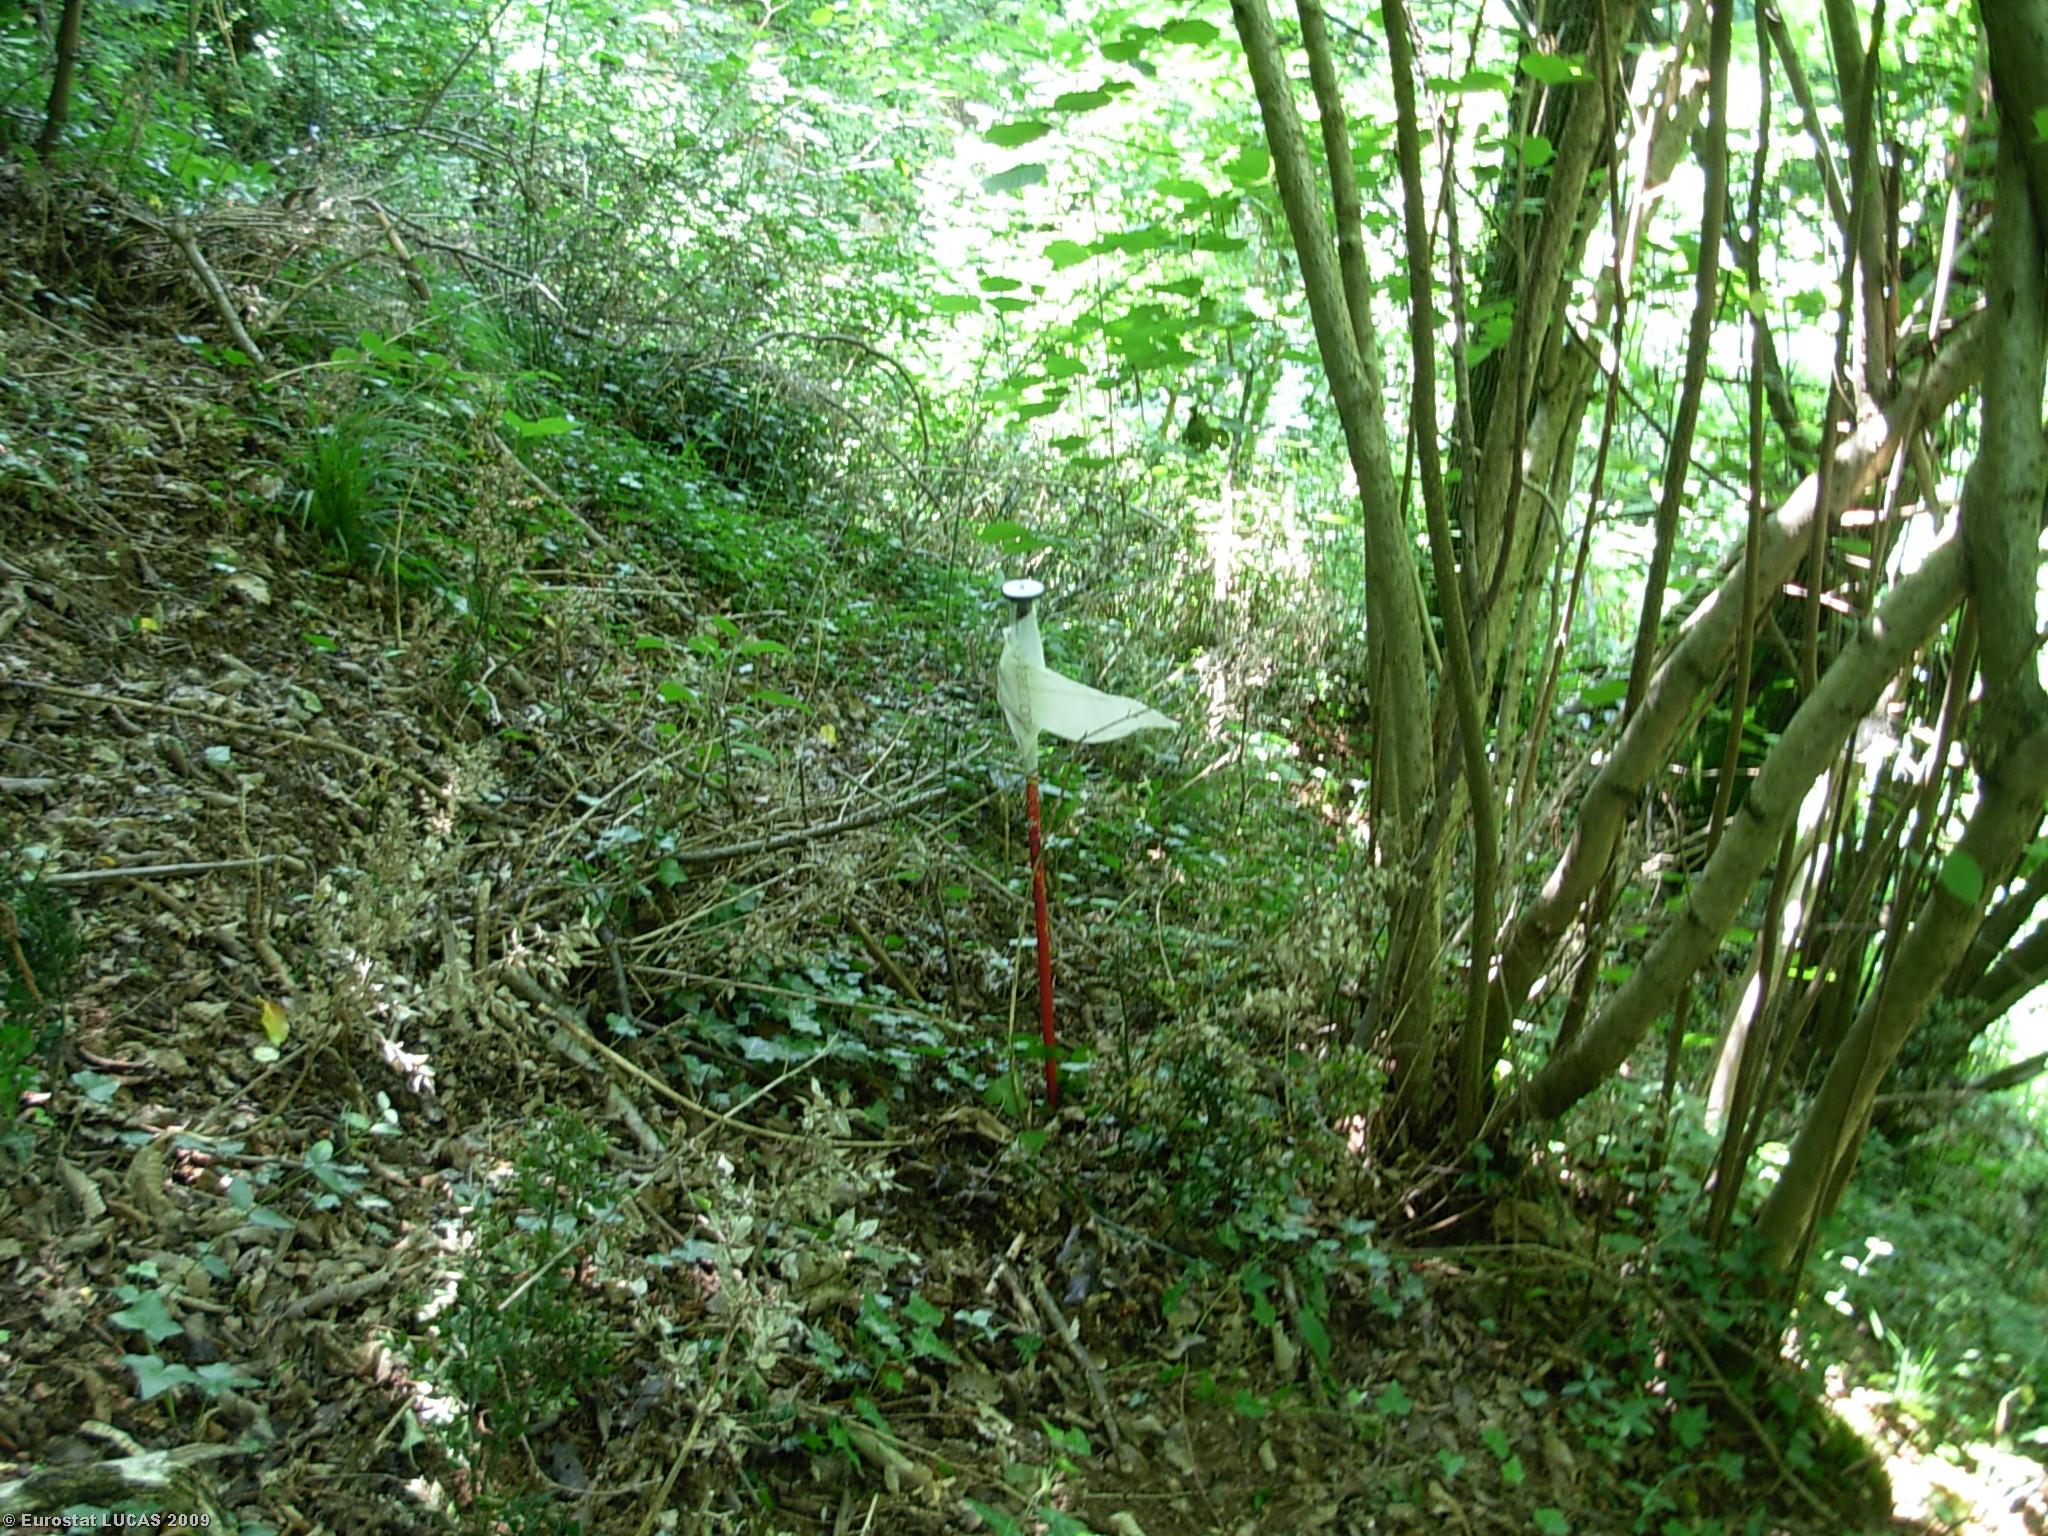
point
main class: Woodland
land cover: Broadleaved woodland
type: mountainous beech forest
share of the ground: > 75 %
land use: Unused
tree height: > 5 m
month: June
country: IT
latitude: 45.5575
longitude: 10.4476
